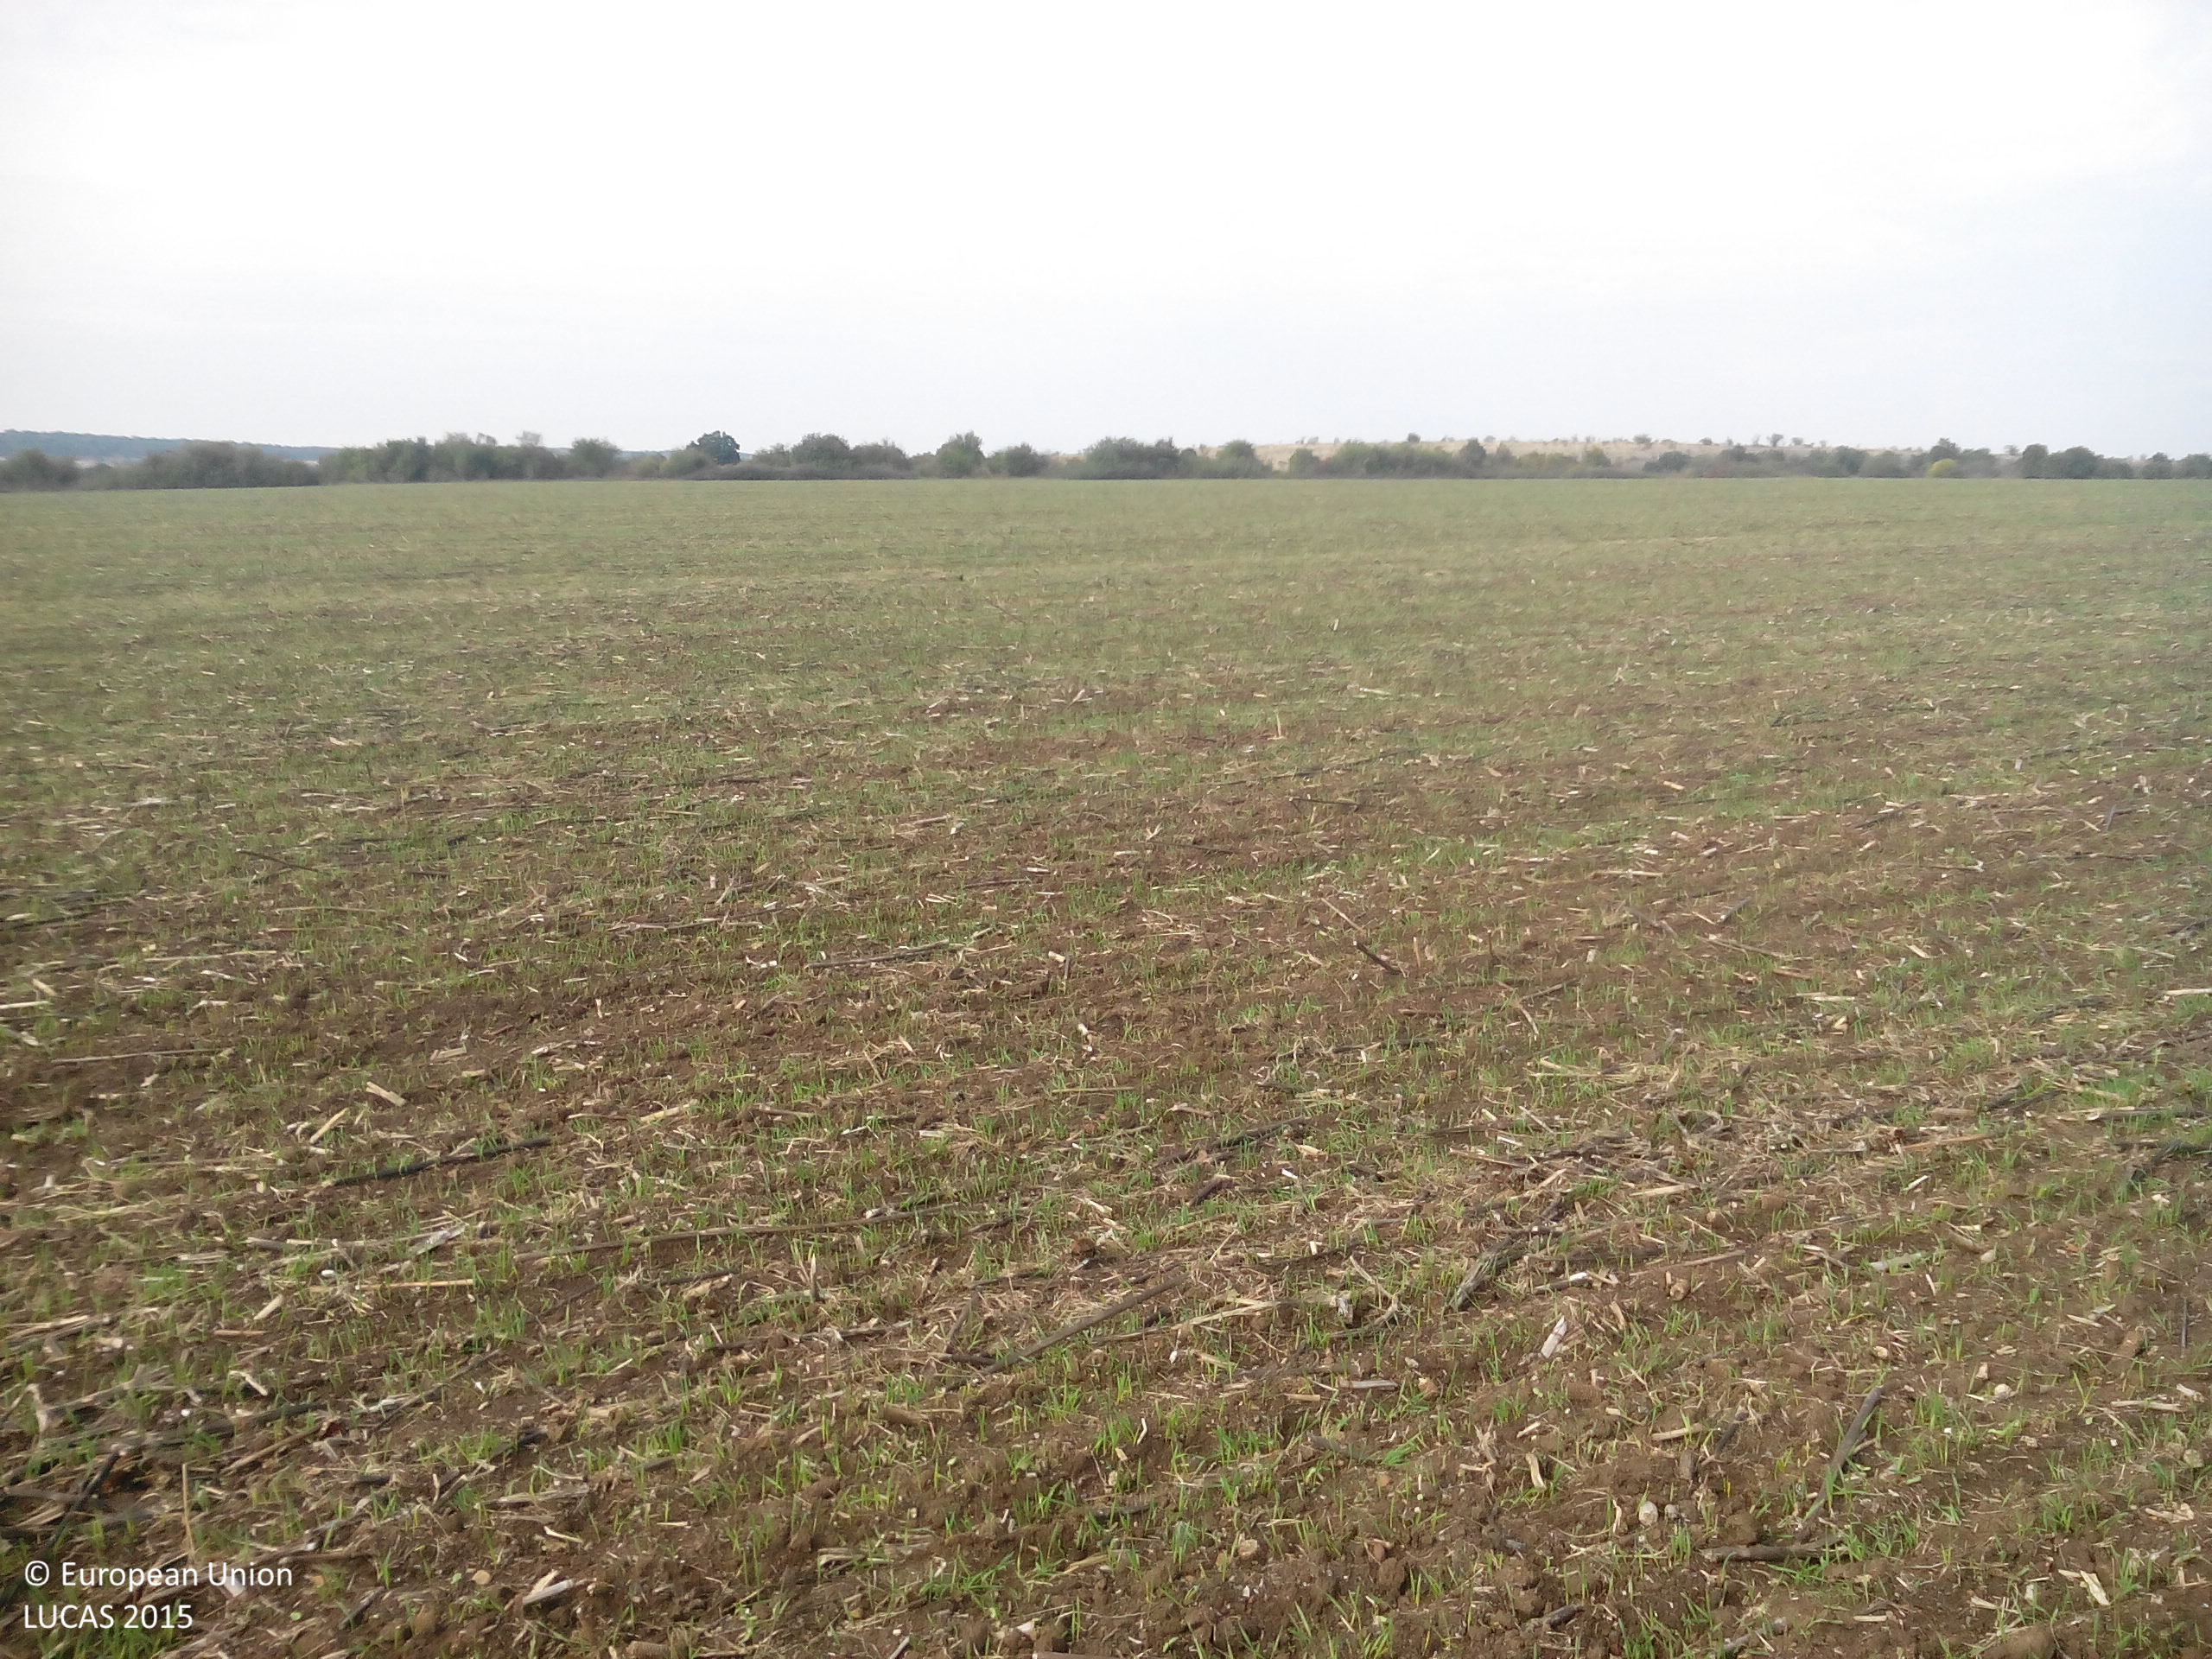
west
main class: Cropland
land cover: Common wheat
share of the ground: 10 - 25 %
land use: Agriculture (excluding fallow land and kitchen gardens)
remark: Harvested field
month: October
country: BG
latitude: 43.2026
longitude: 23.9438
